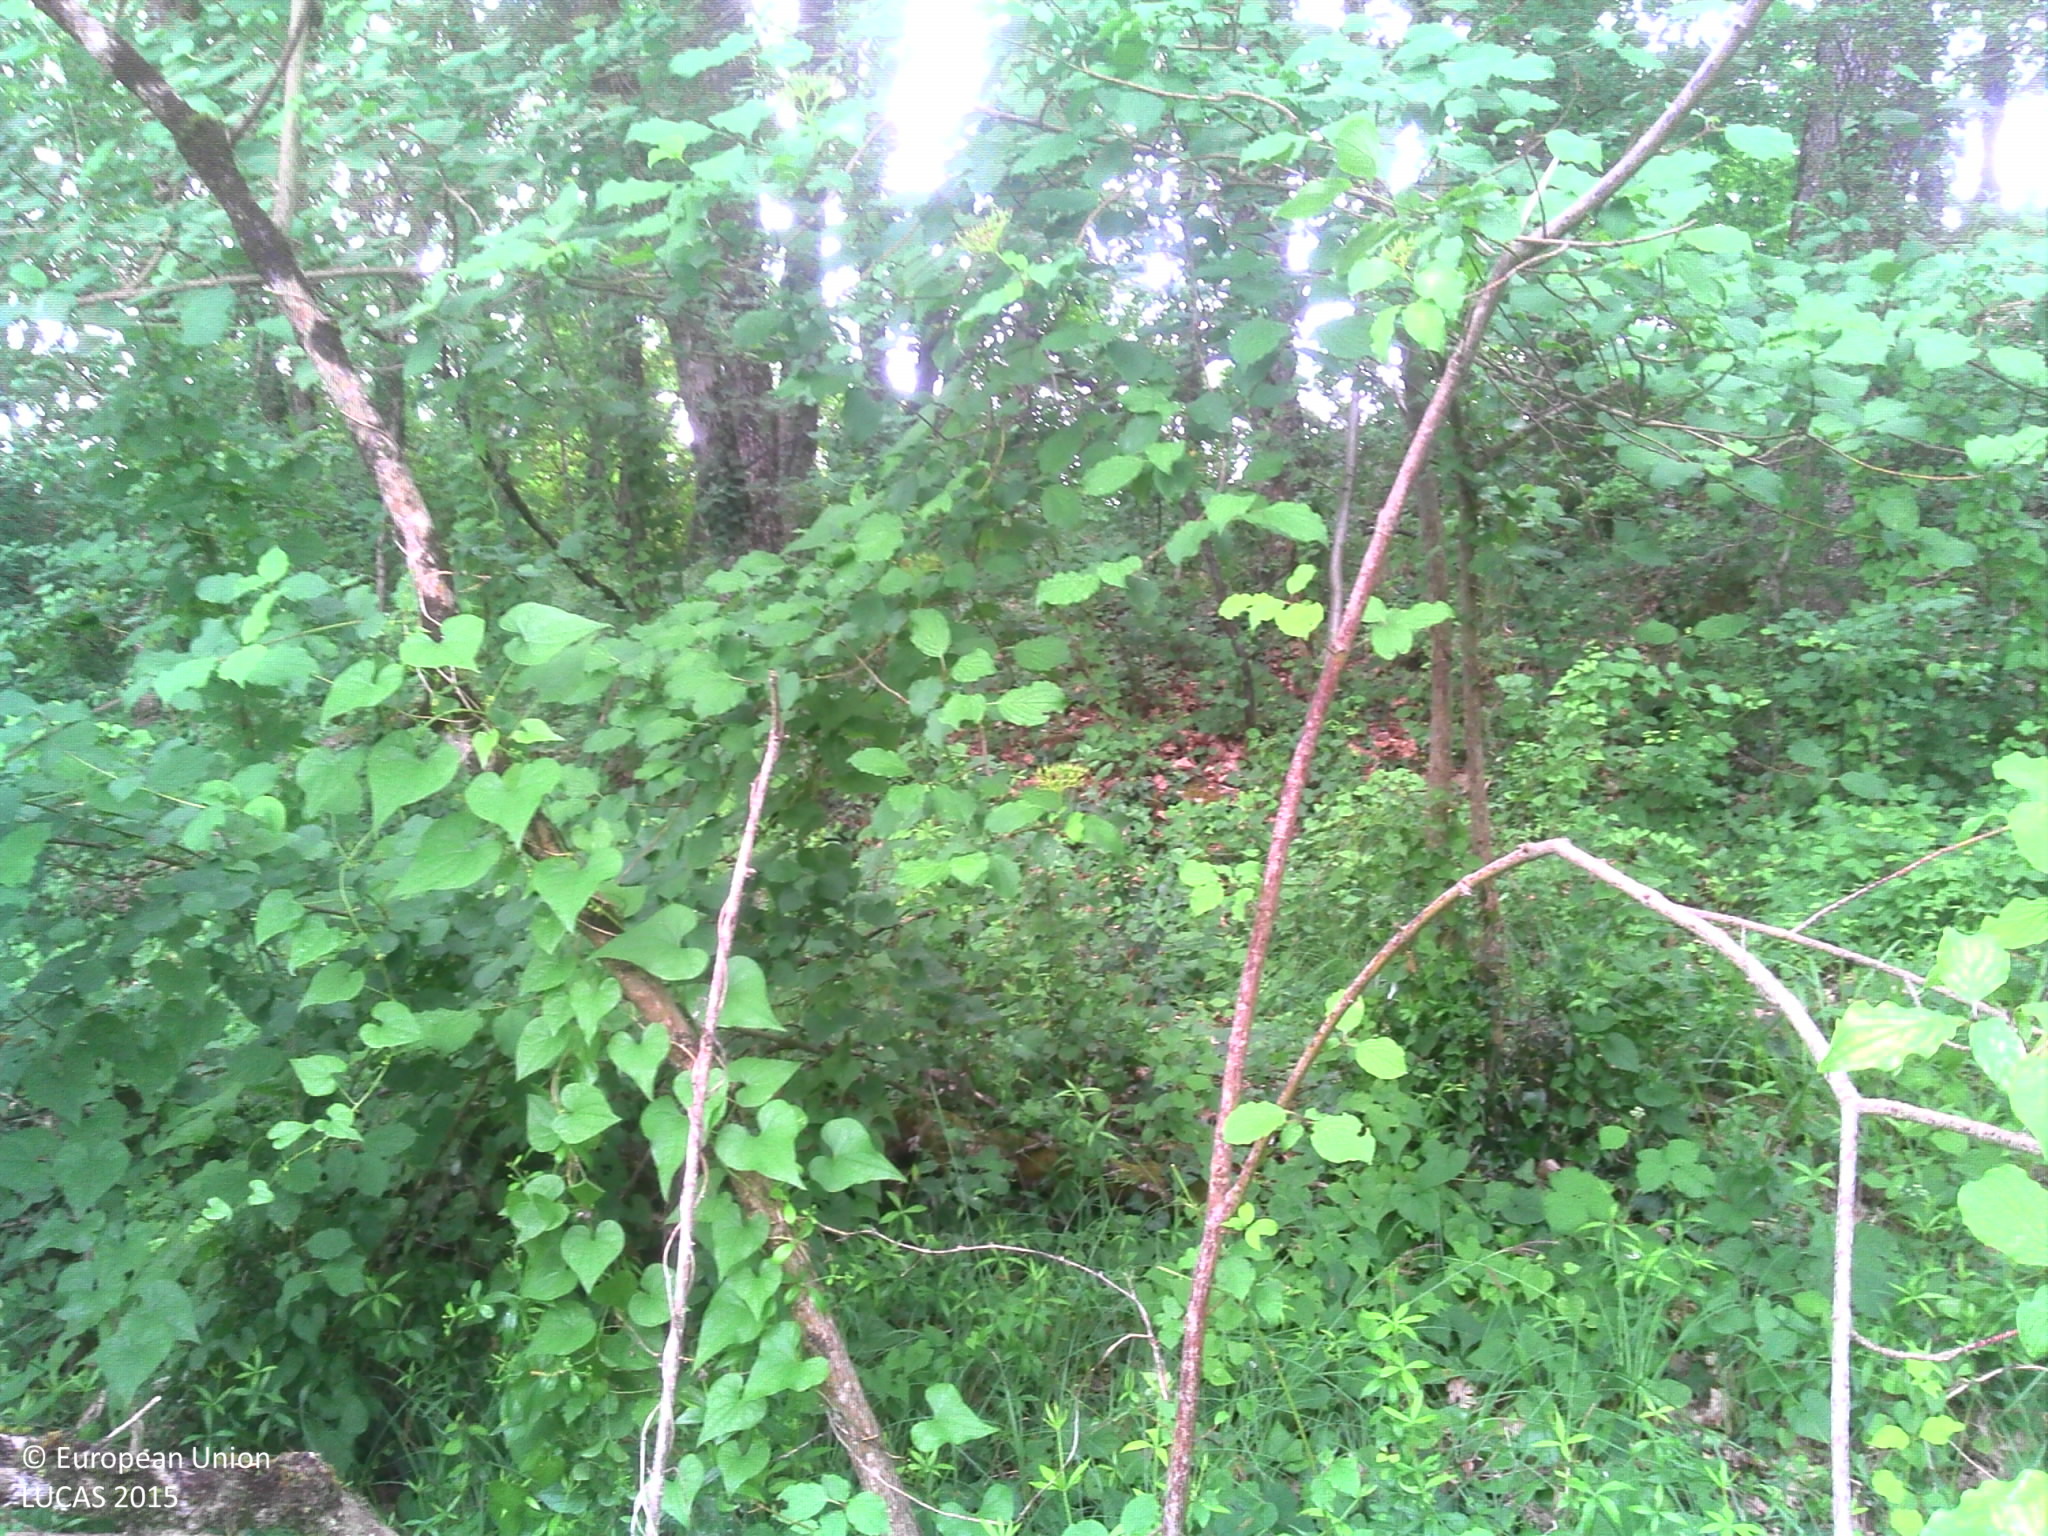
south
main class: Woodland
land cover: Broadleaved woodland
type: mesophytic deciduous forest
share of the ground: > 75 %
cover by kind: broadleaved forest trees 100 %
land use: Forestry
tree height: > 5 m
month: June
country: FR
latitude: 43.7246
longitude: 2.1221
